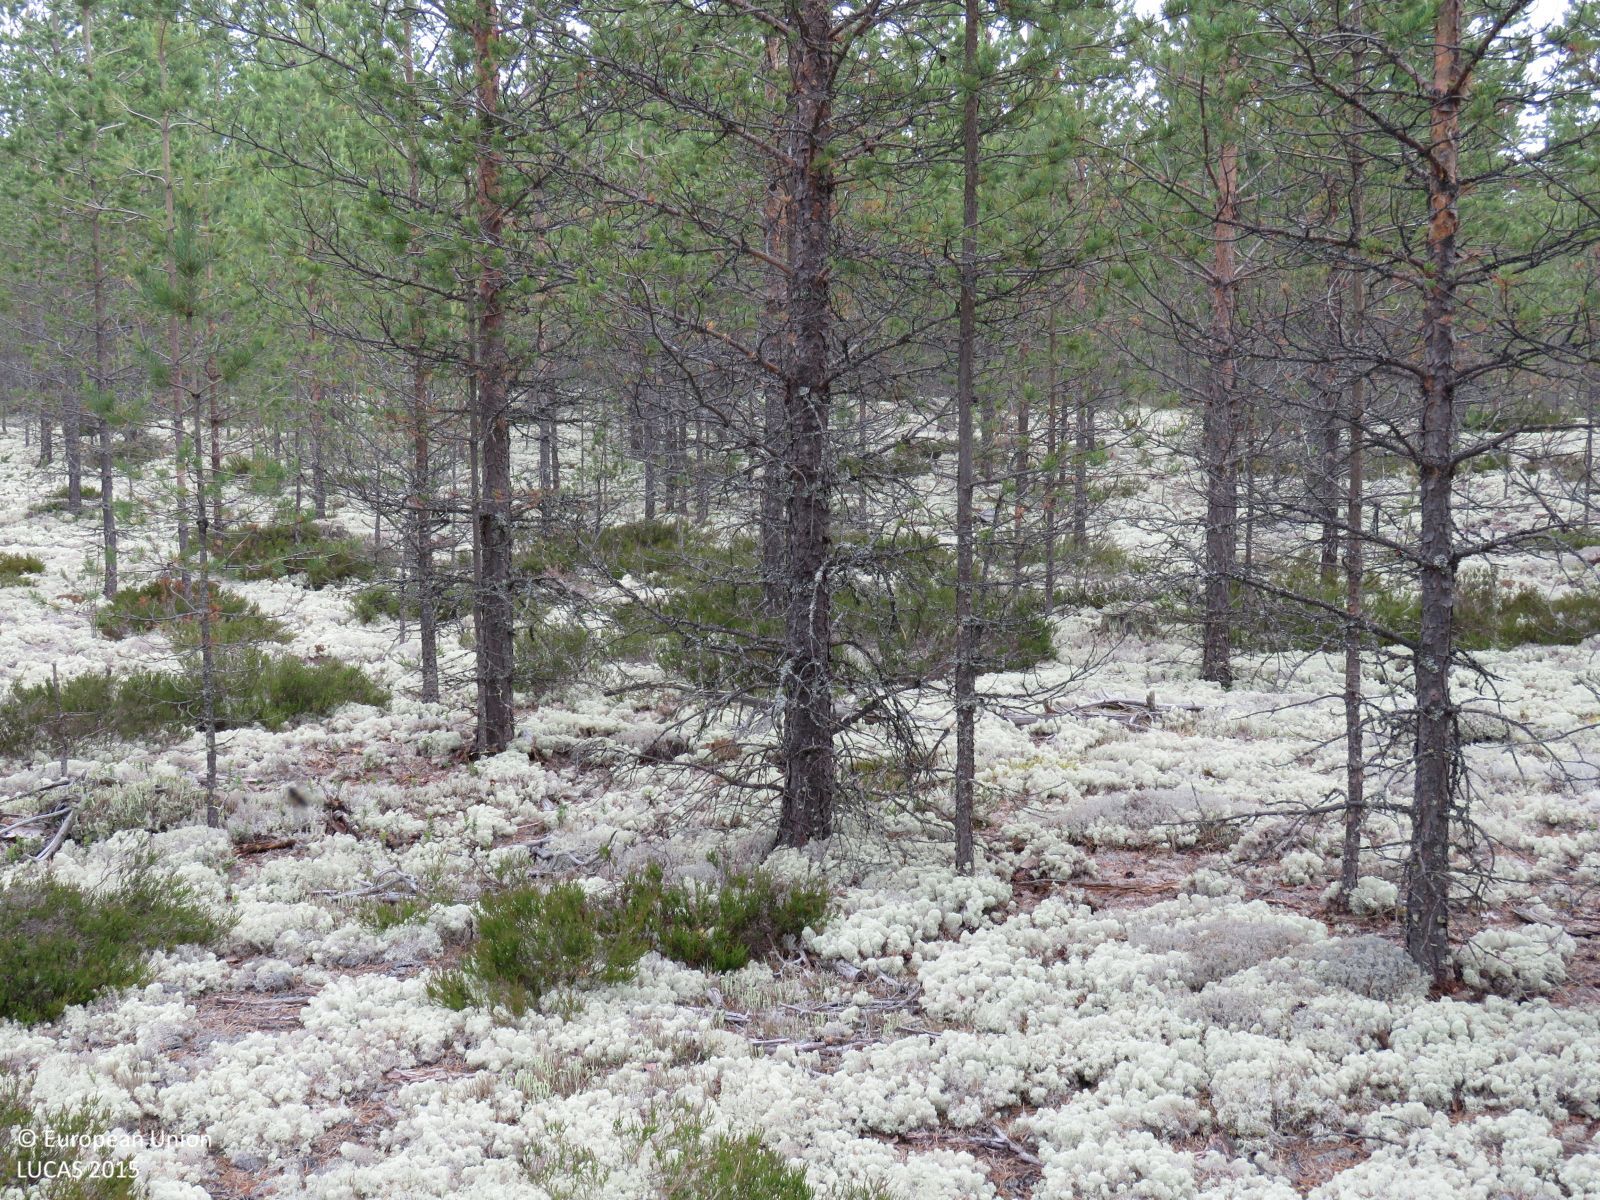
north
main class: Woodland
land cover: Pine dominated coniferous woodland
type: boreal forest
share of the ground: 50 - 75 %
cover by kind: coniferous forest trees 50 %, lichens and mosses 35 %, shrubs 10 %, unconsolidated bare surface 5 %
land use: Forestry
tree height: > 5 m
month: July
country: FI
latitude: 64.4822
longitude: 26.7446
